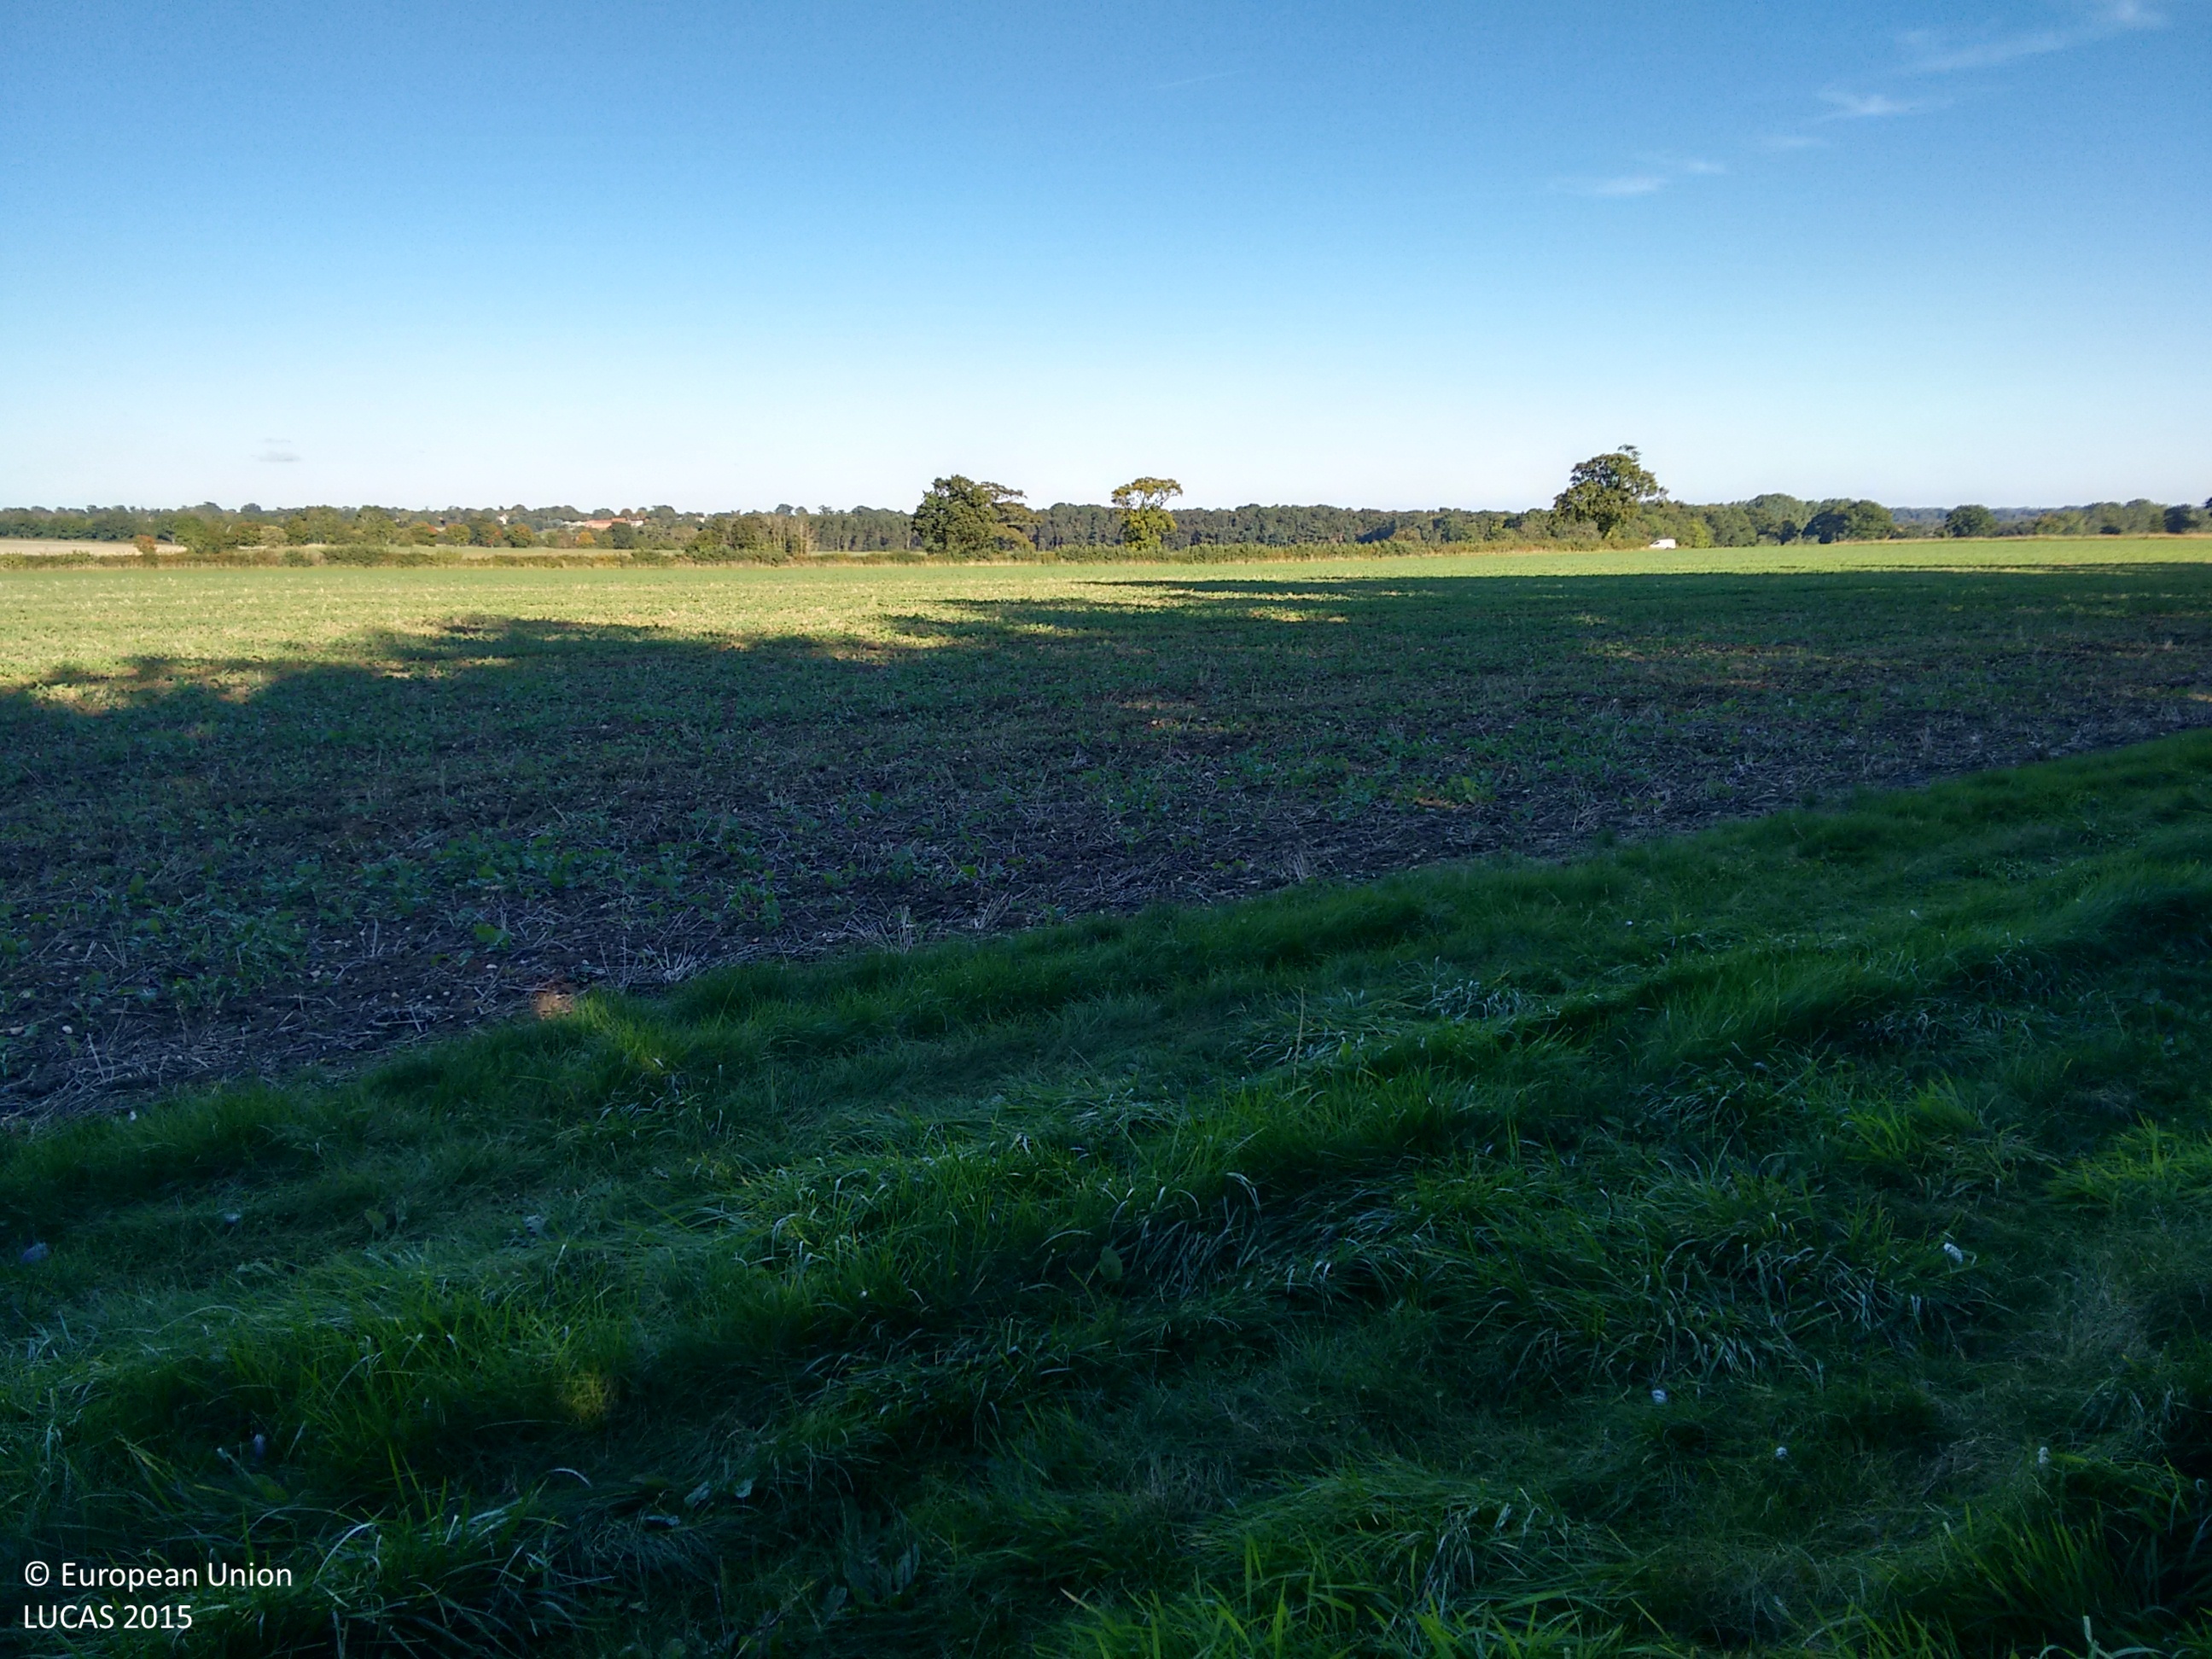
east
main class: Woodland
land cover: Pine dominated mixed woodland
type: exotic forest
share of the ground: > 75 %
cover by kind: coniferous forest trees 75 %, broadleaved forest trees 25 %
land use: Semi-natural and natural areas not in use
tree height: > 5 m
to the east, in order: Pine dominated mixed woodland; Ditches and canals; Fences; Grass margins; Rape and turnip rape; Grassland without tree/shrub cover; Ditches and canals; Managed hedges; Grassland without tree/shrub cover; Other bare soil
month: September
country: GB
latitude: 52.4207
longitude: 1.3187
